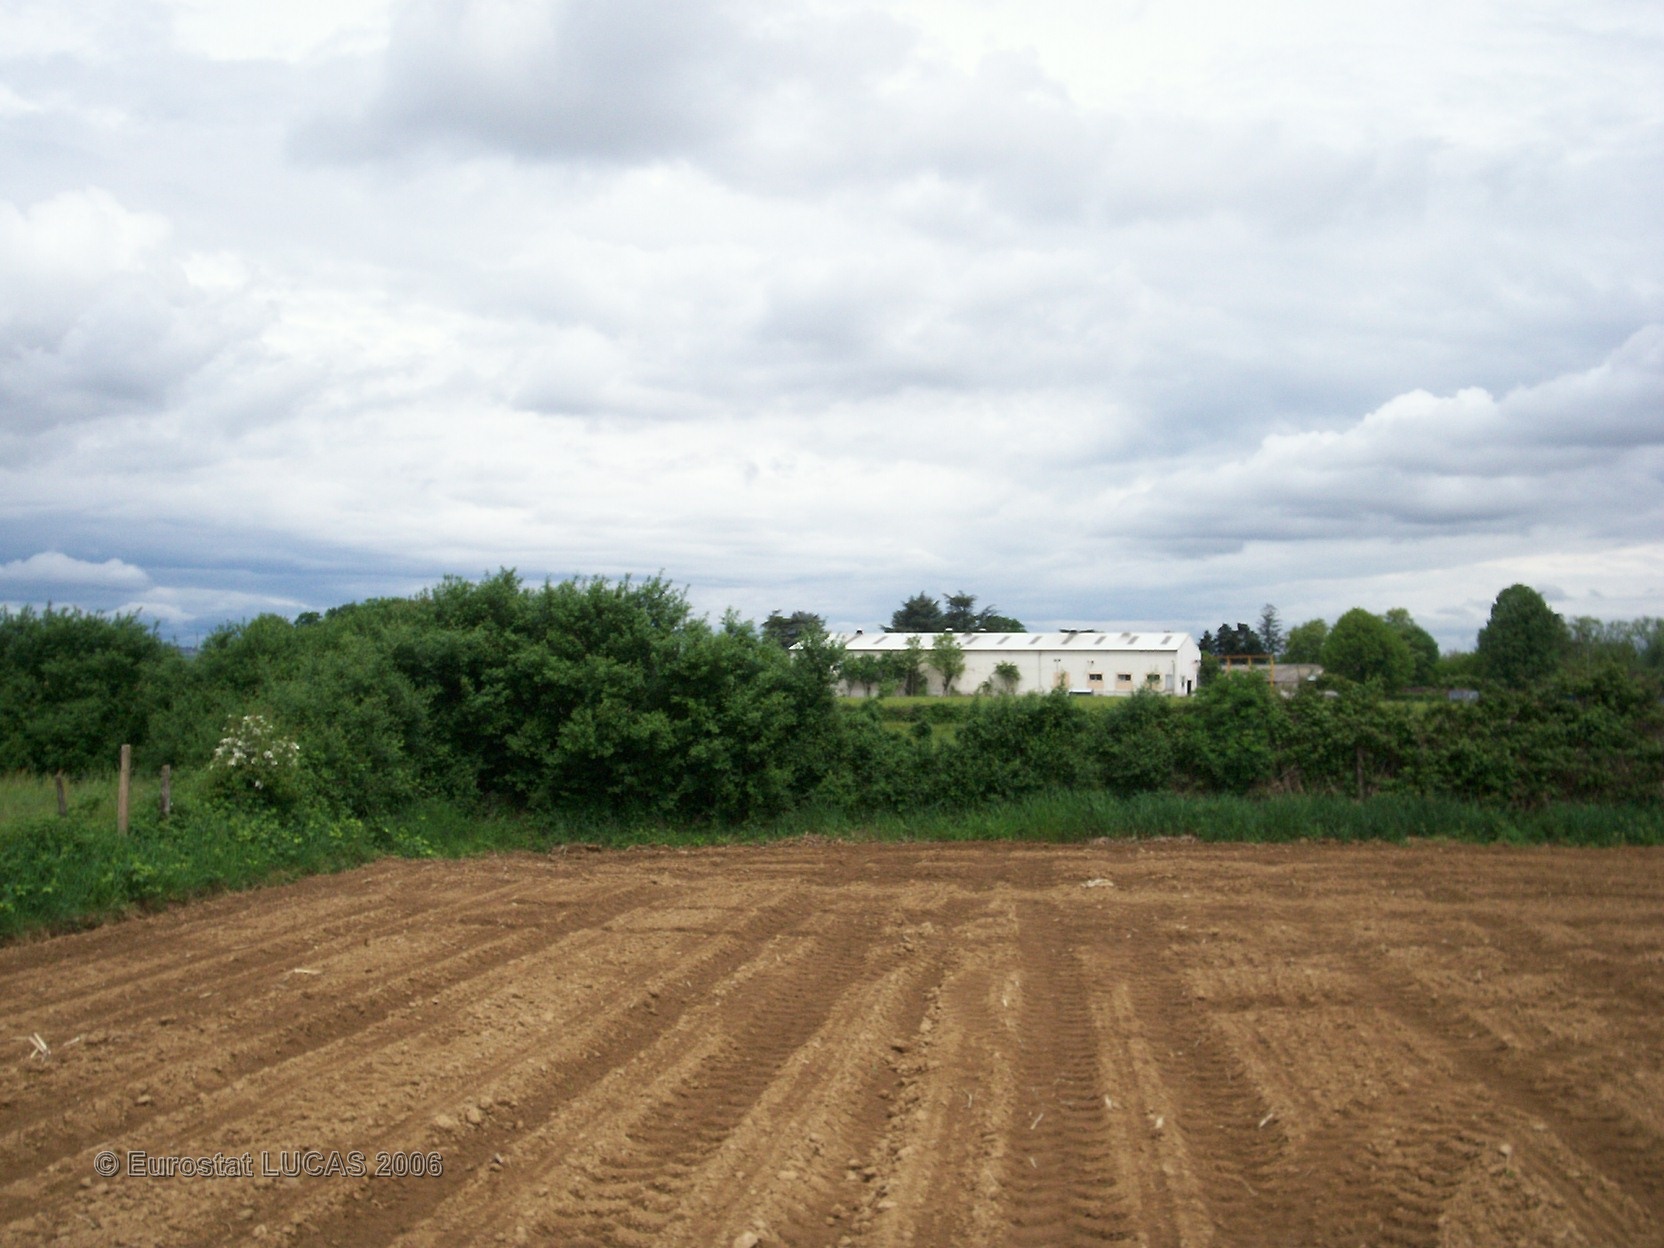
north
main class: Cropland
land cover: Maize
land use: Agriculture (excluding fallow land and kitchen gardens)
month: May
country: FR
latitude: 45.9157
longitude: 4.7557
